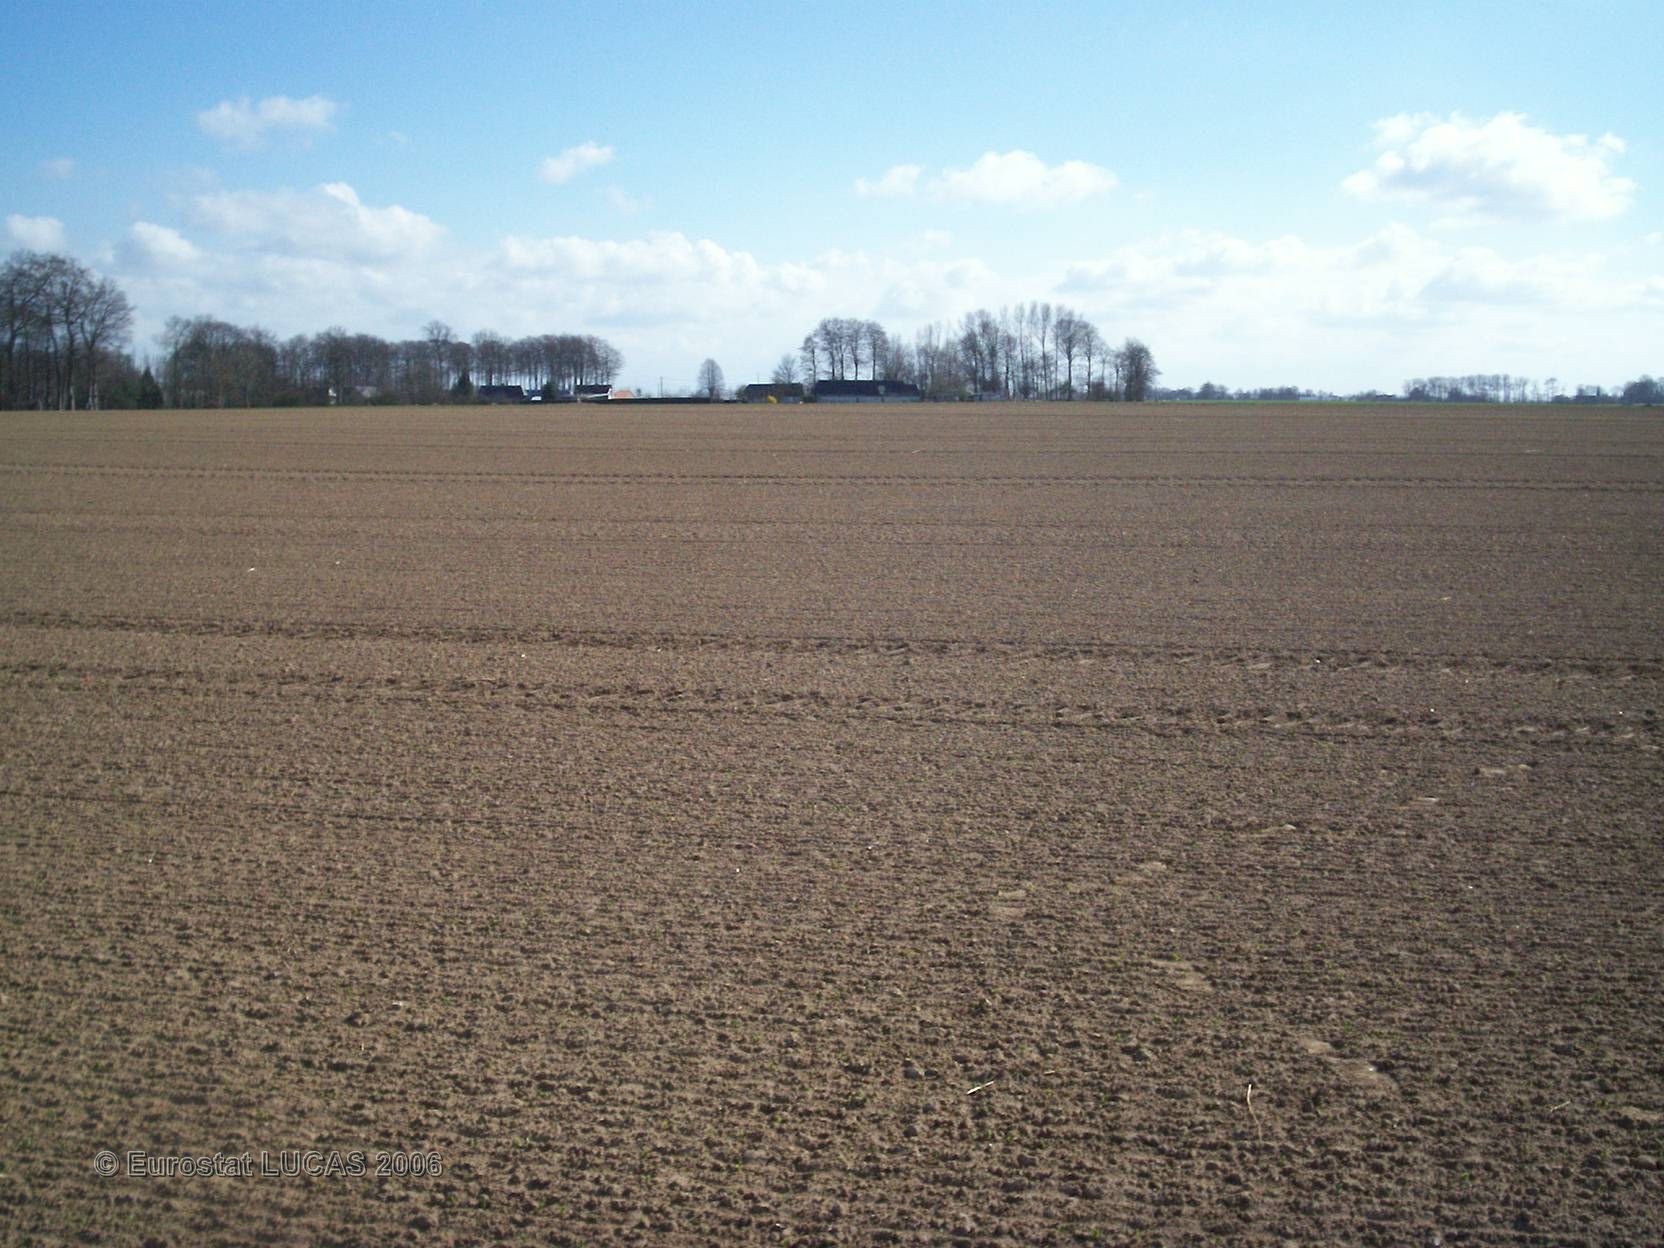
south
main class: Cropland
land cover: Dry pulses
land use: Agriculture (excluding fallow land and kitchen gardens)
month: April
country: FR
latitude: 49.7751
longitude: 0.7969
